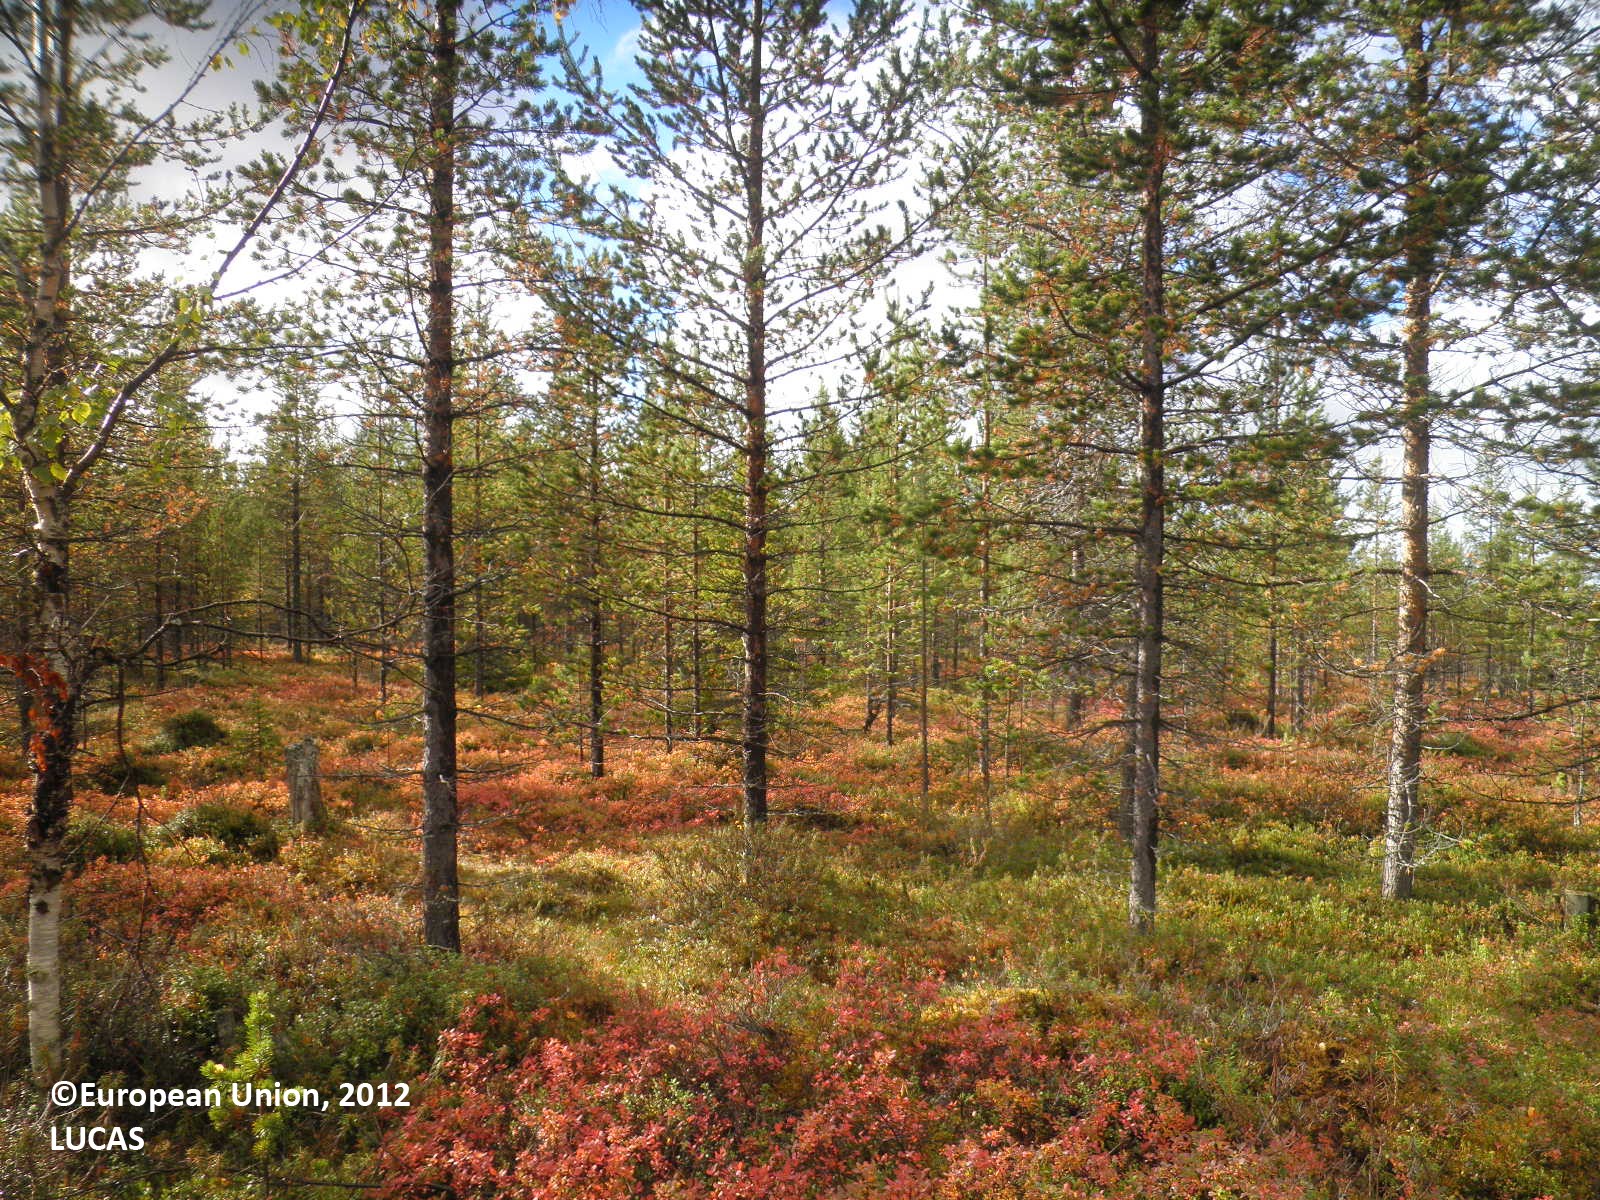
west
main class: Woodland
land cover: Pine dominated coniferous woodland
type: boreal forest
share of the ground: 25 - 50 %
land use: Forestry
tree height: > 5 m
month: September
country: FI
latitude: 67.6731
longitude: 28.6960
